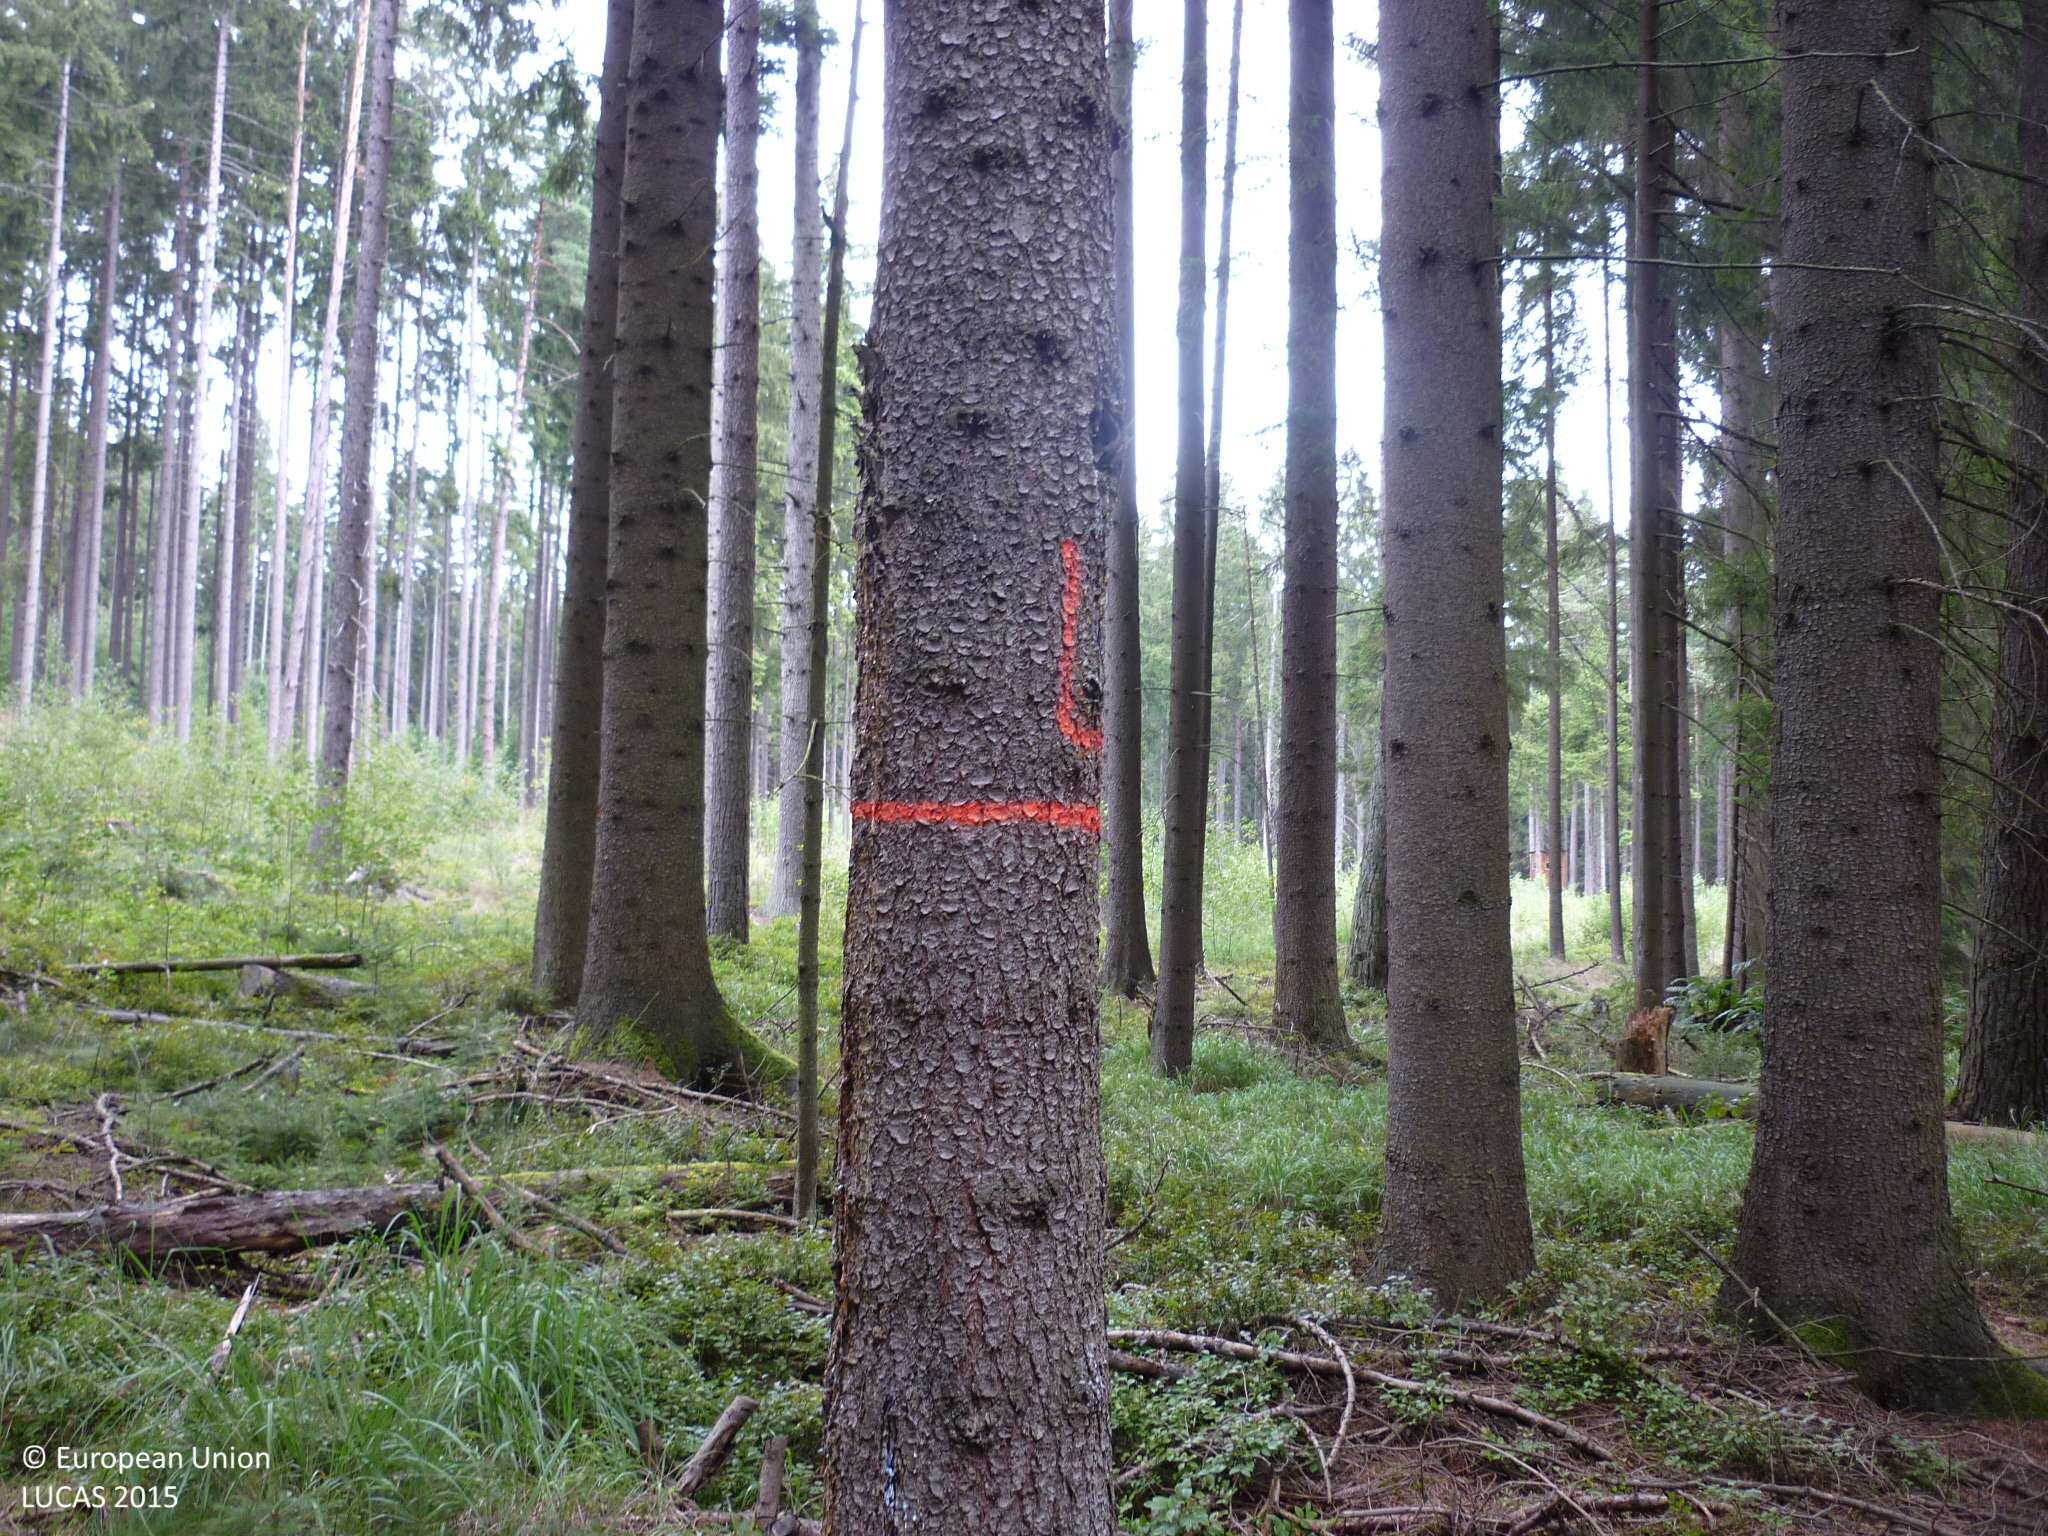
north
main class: Woodland
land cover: Spruce dominated coniferous woodland
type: hemiboreal forest and nemoral coniferous forest and mixed broadleaved-coniferous forest
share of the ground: > 75 %
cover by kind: coniferous forest trees 95 %, lichens and mosses 5 %
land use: Forestry
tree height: > 5 m
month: September
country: AT
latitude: 48.8262
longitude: 15.1102
